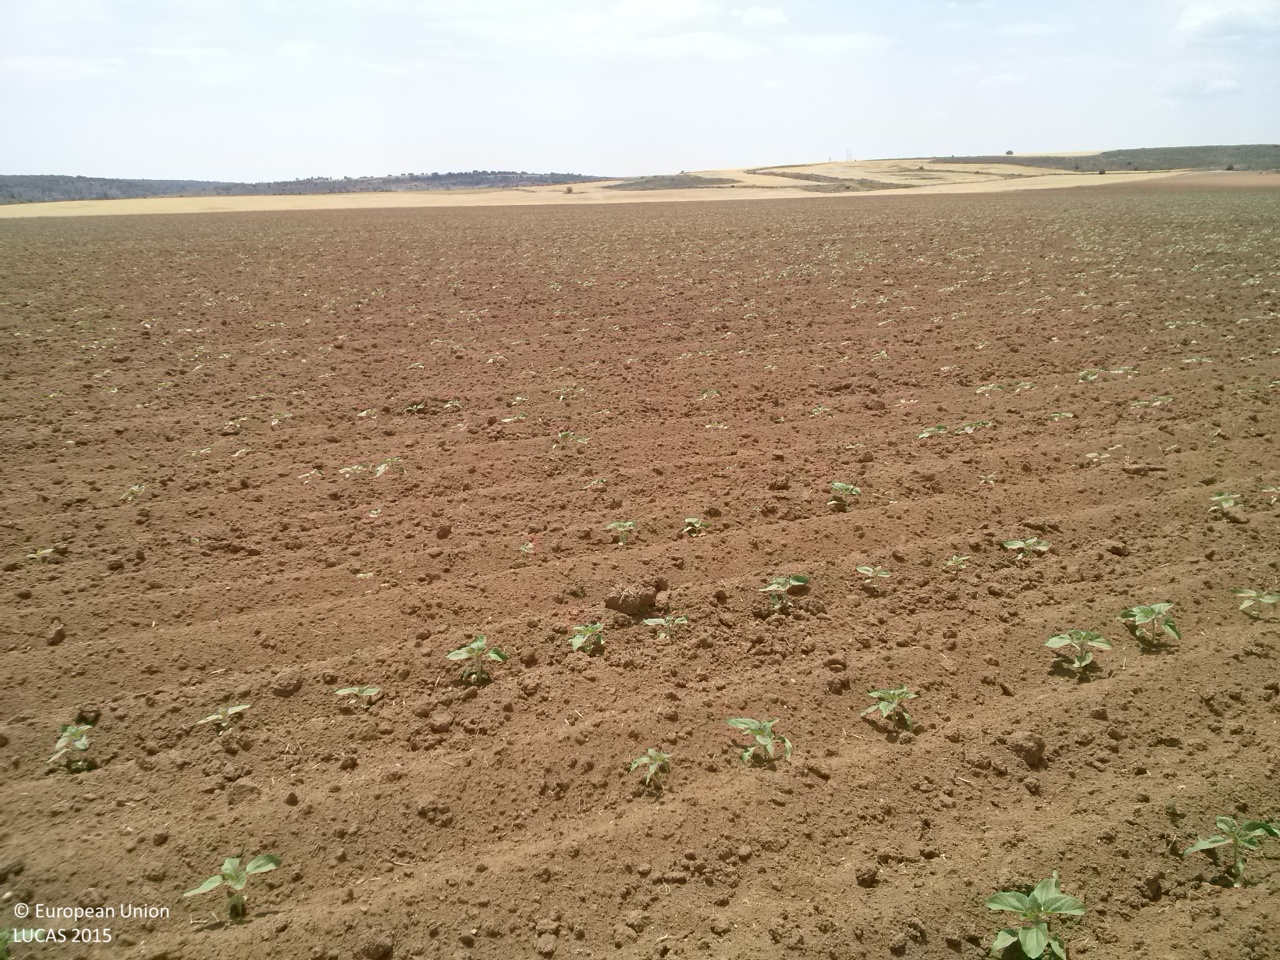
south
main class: Cropland
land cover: Sunflower
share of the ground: < 10 %
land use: Agriculture (excluding fallow land and kitchen gardens)
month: June
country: ES
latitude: 39.9188
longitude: -1.7924
